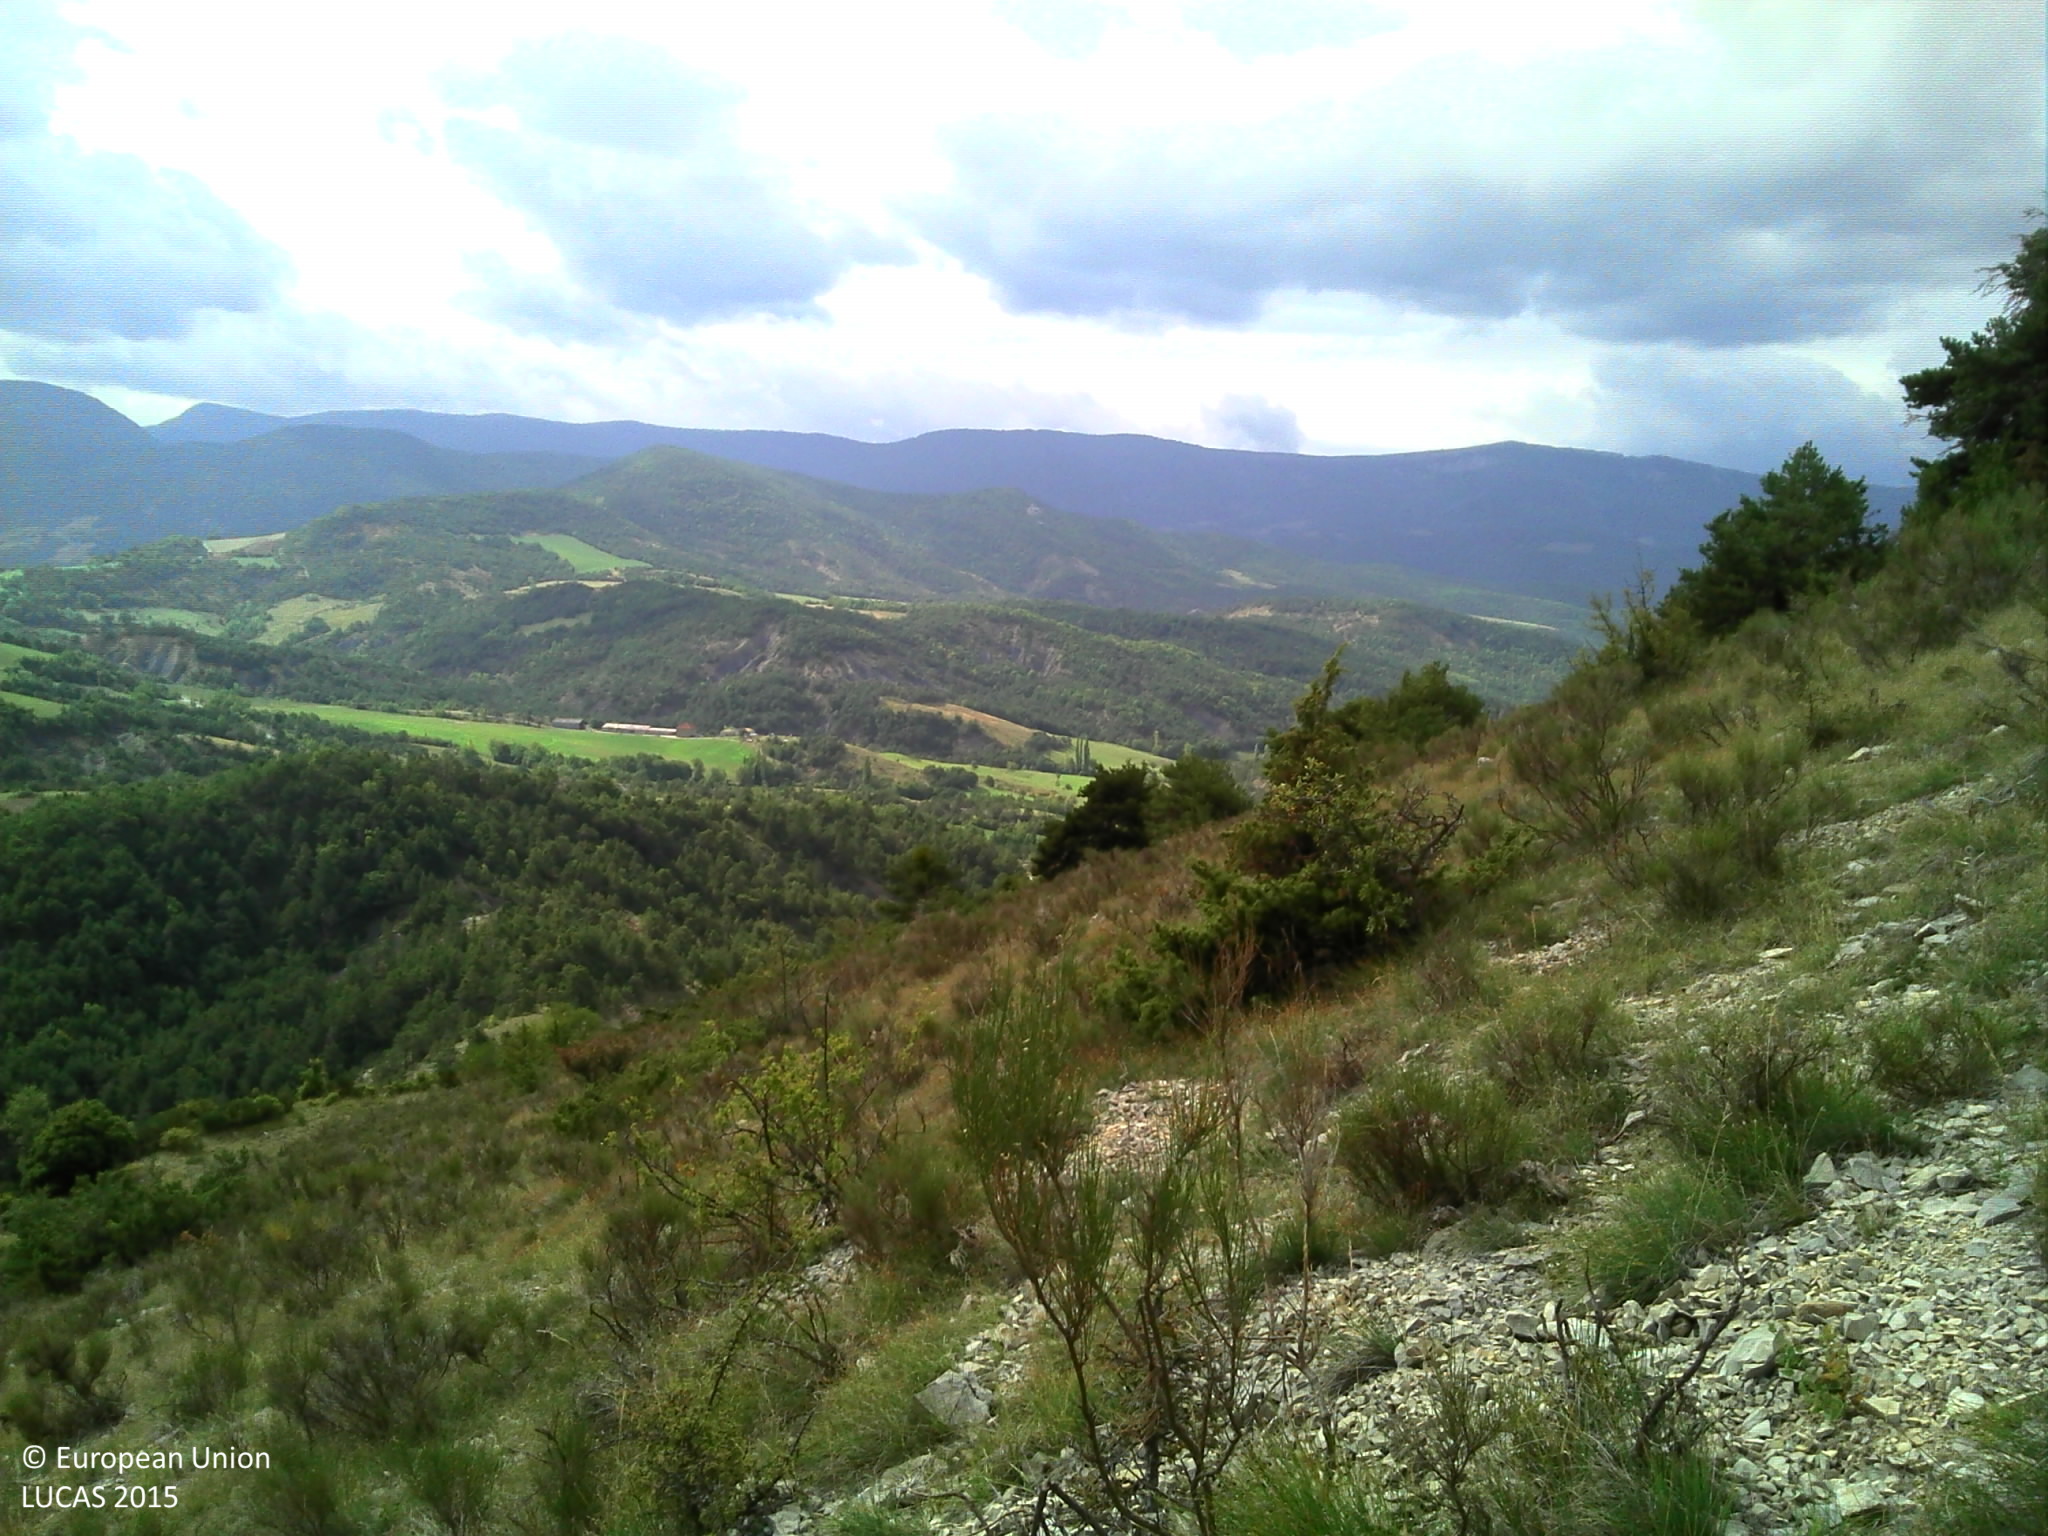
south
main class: Shrubland
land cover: Shrubland with sparse tree cover
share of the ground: 25 - 50 %
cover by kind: shrubs 55 %, herbaceous plants 20 %, consolidated bare surface 20 %, broadleaved forest trees 5 %
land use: Semi-natural and natural areas not in use
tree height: > 5 m
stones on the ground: 10 - 25 %
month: September
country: FR
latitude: 44.3975
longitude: 5.5000
